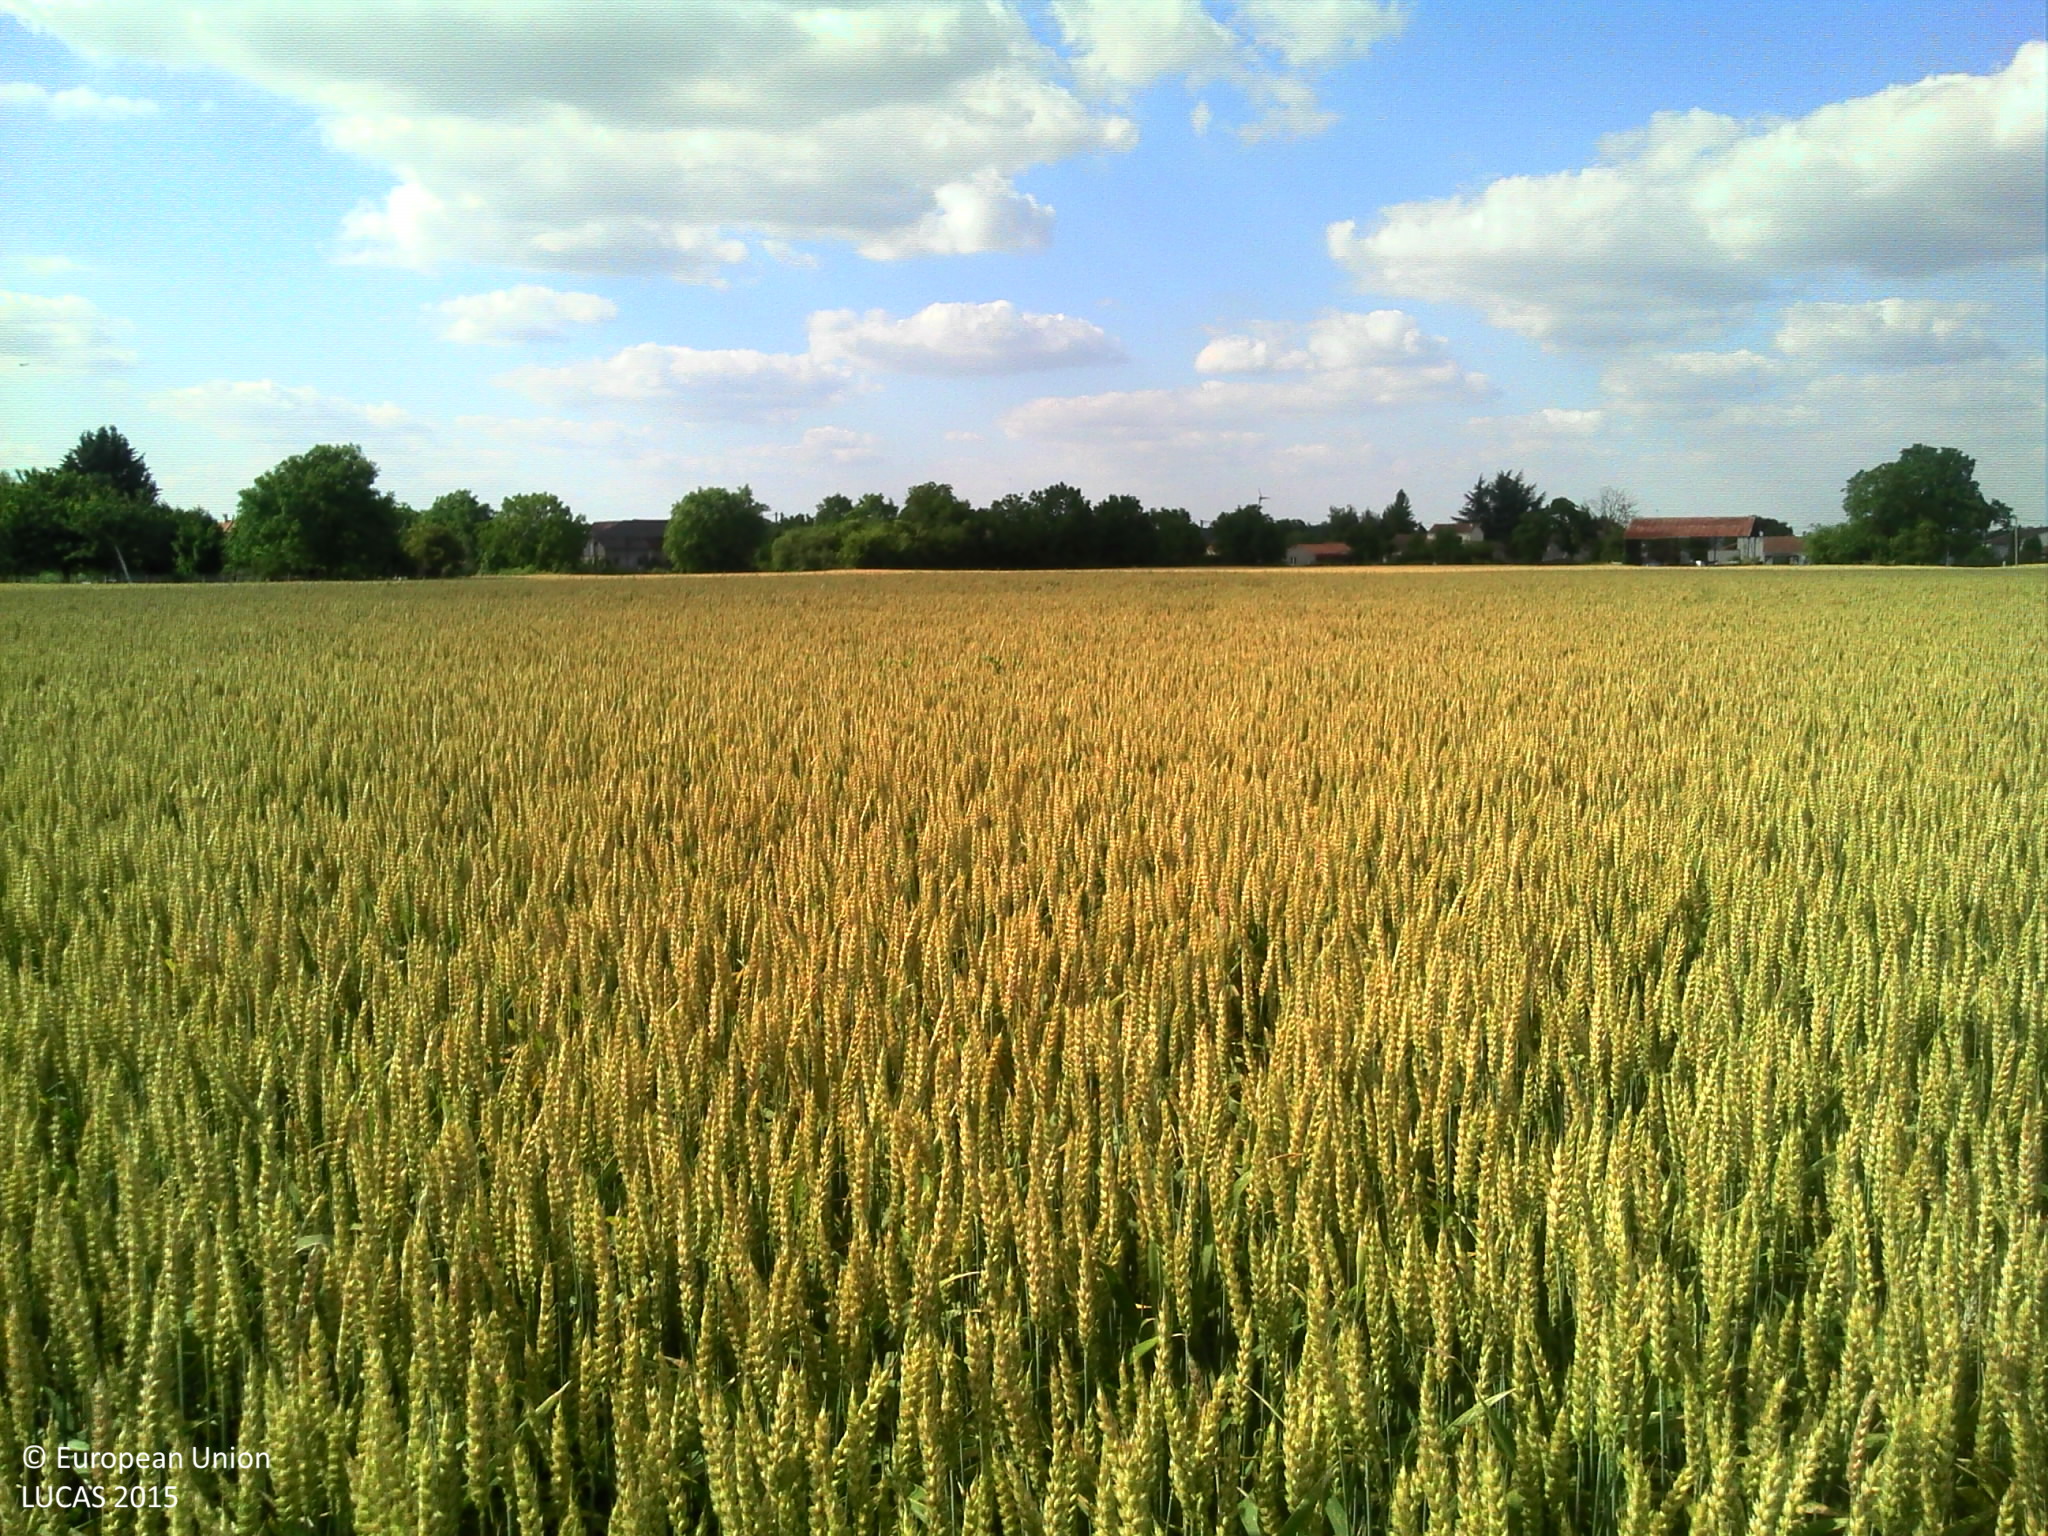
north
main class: Cropland
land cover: Common wheat
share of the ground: > 75 %
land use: Agriculture (excluding fallow land and kitchen gardens)
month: June
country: FR
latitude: 46.7495
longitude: 0.5703
